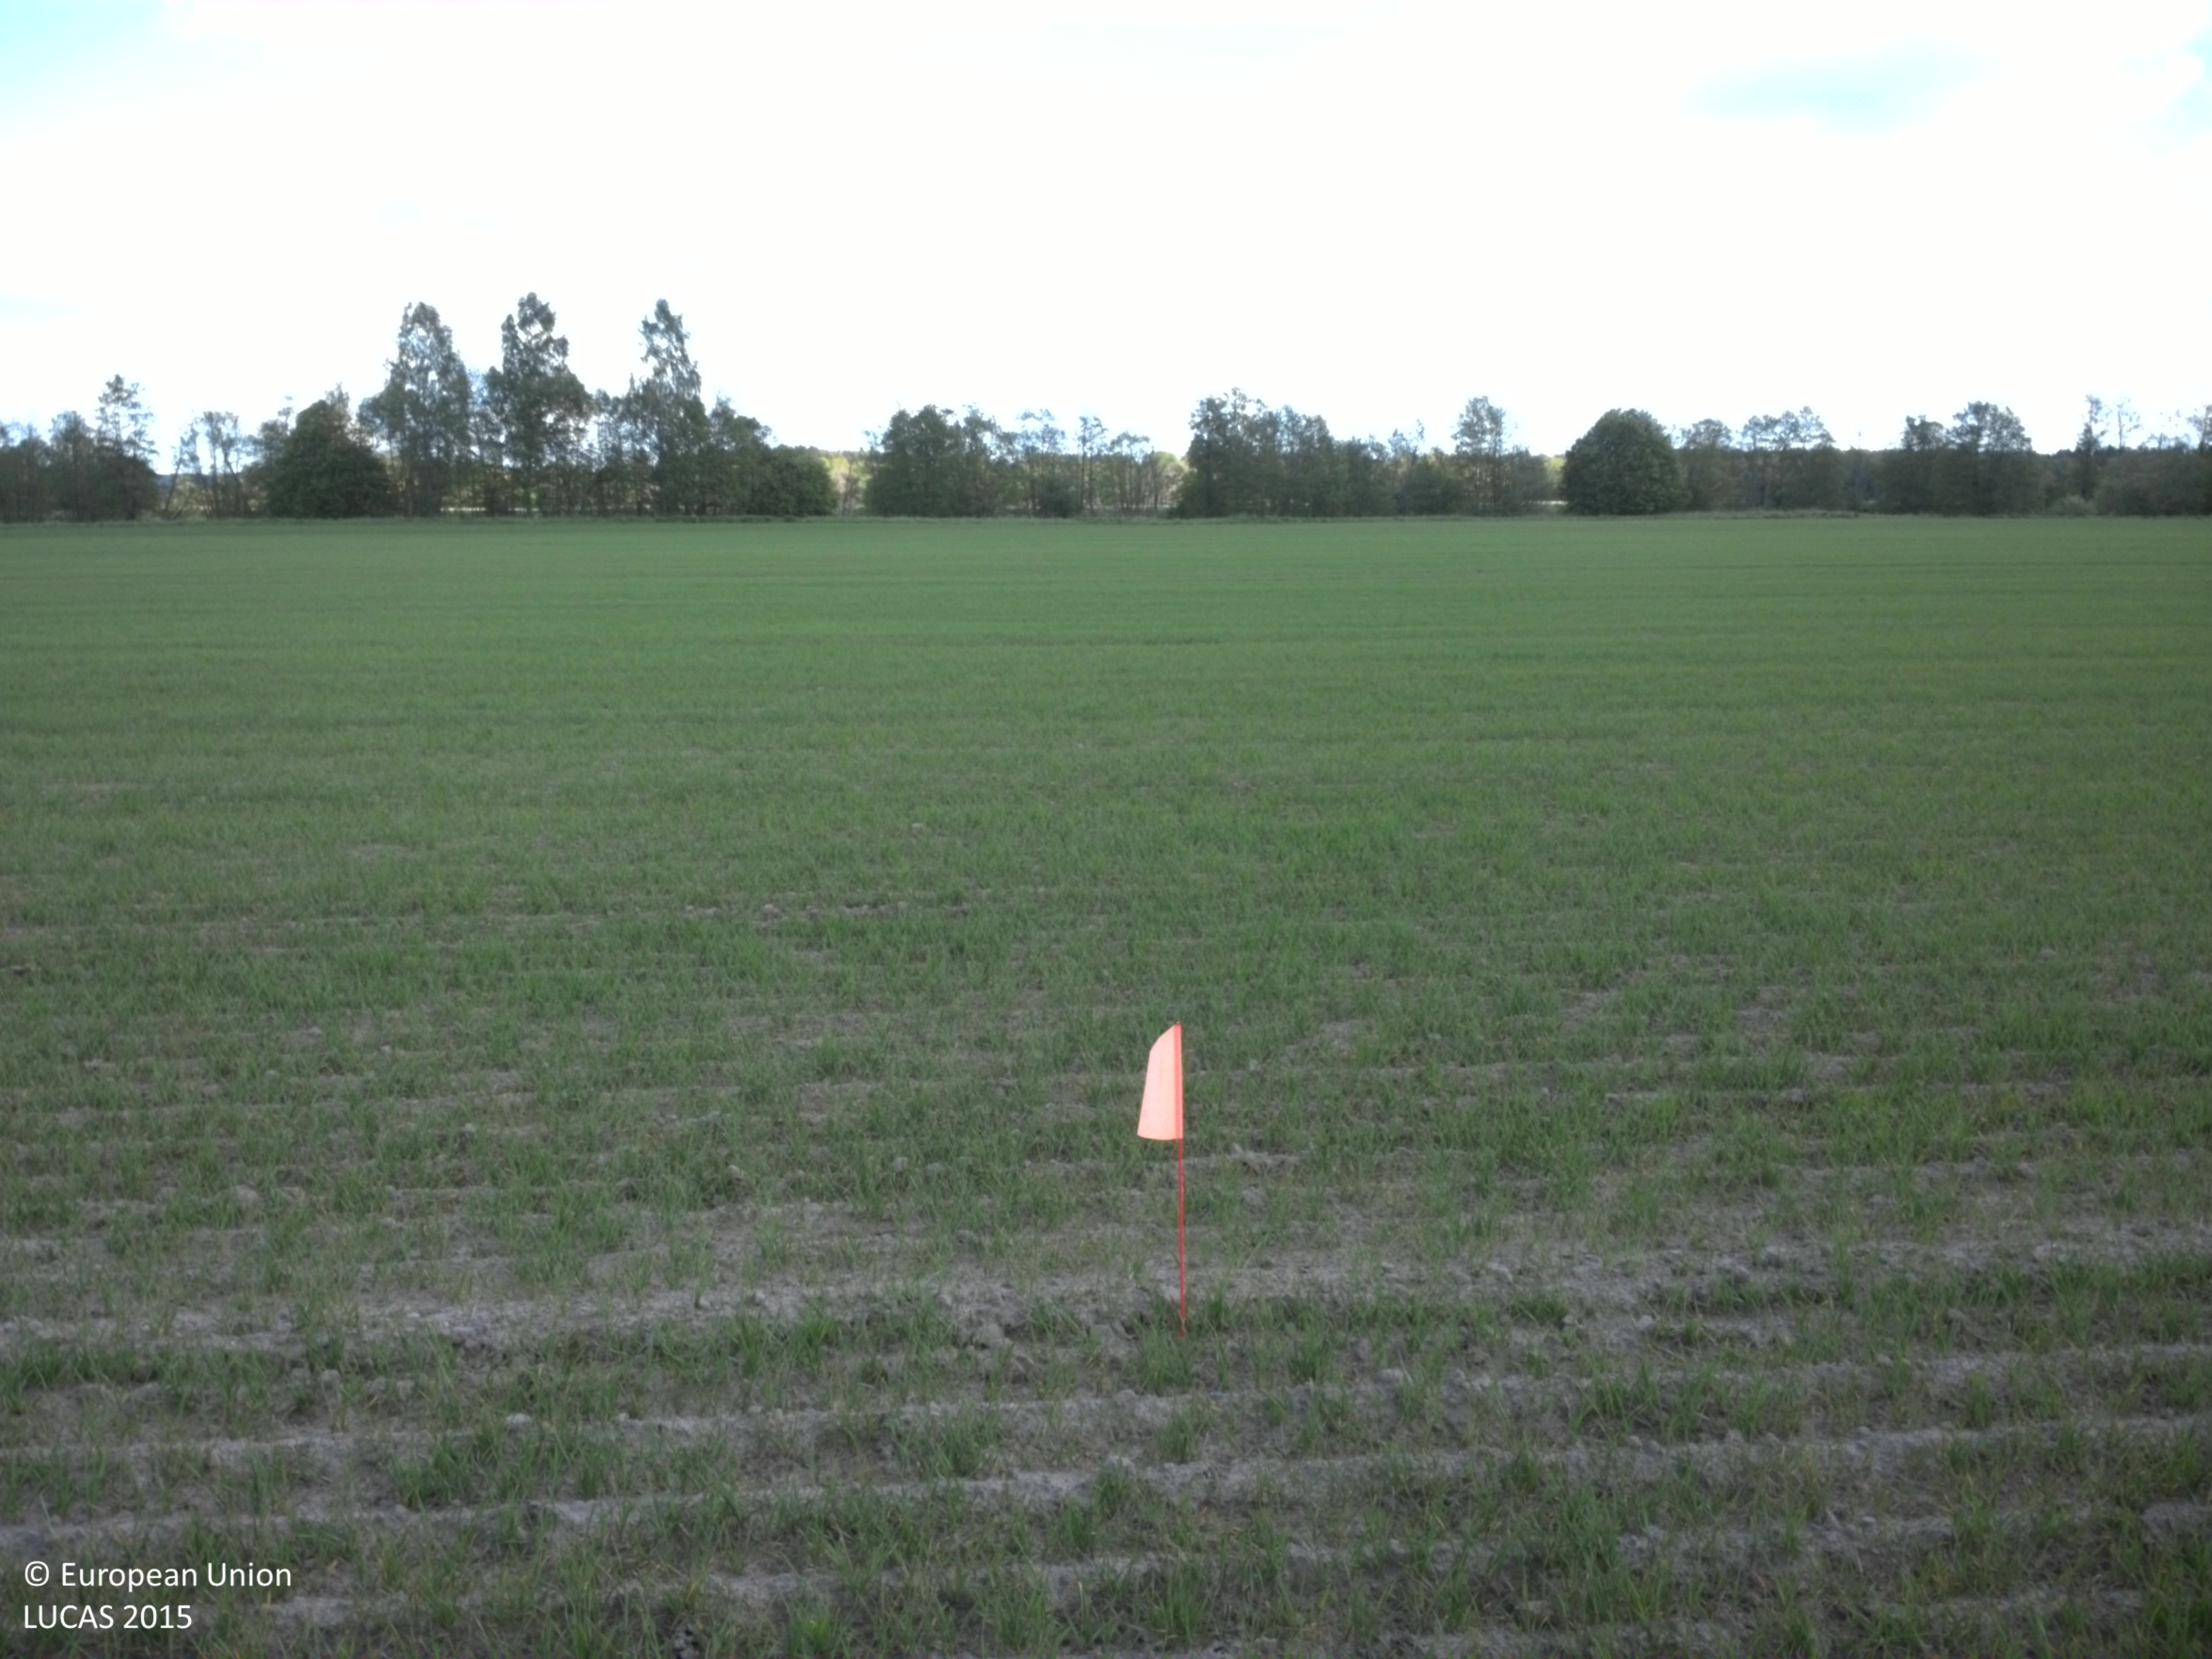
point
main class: Cropland
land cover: Common wheat
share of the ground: 50 - 75 %
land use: Agriculture (excluding fallow land and kitchen gardens)
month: May
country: SE
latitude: 57.3356
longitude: 15.8288
